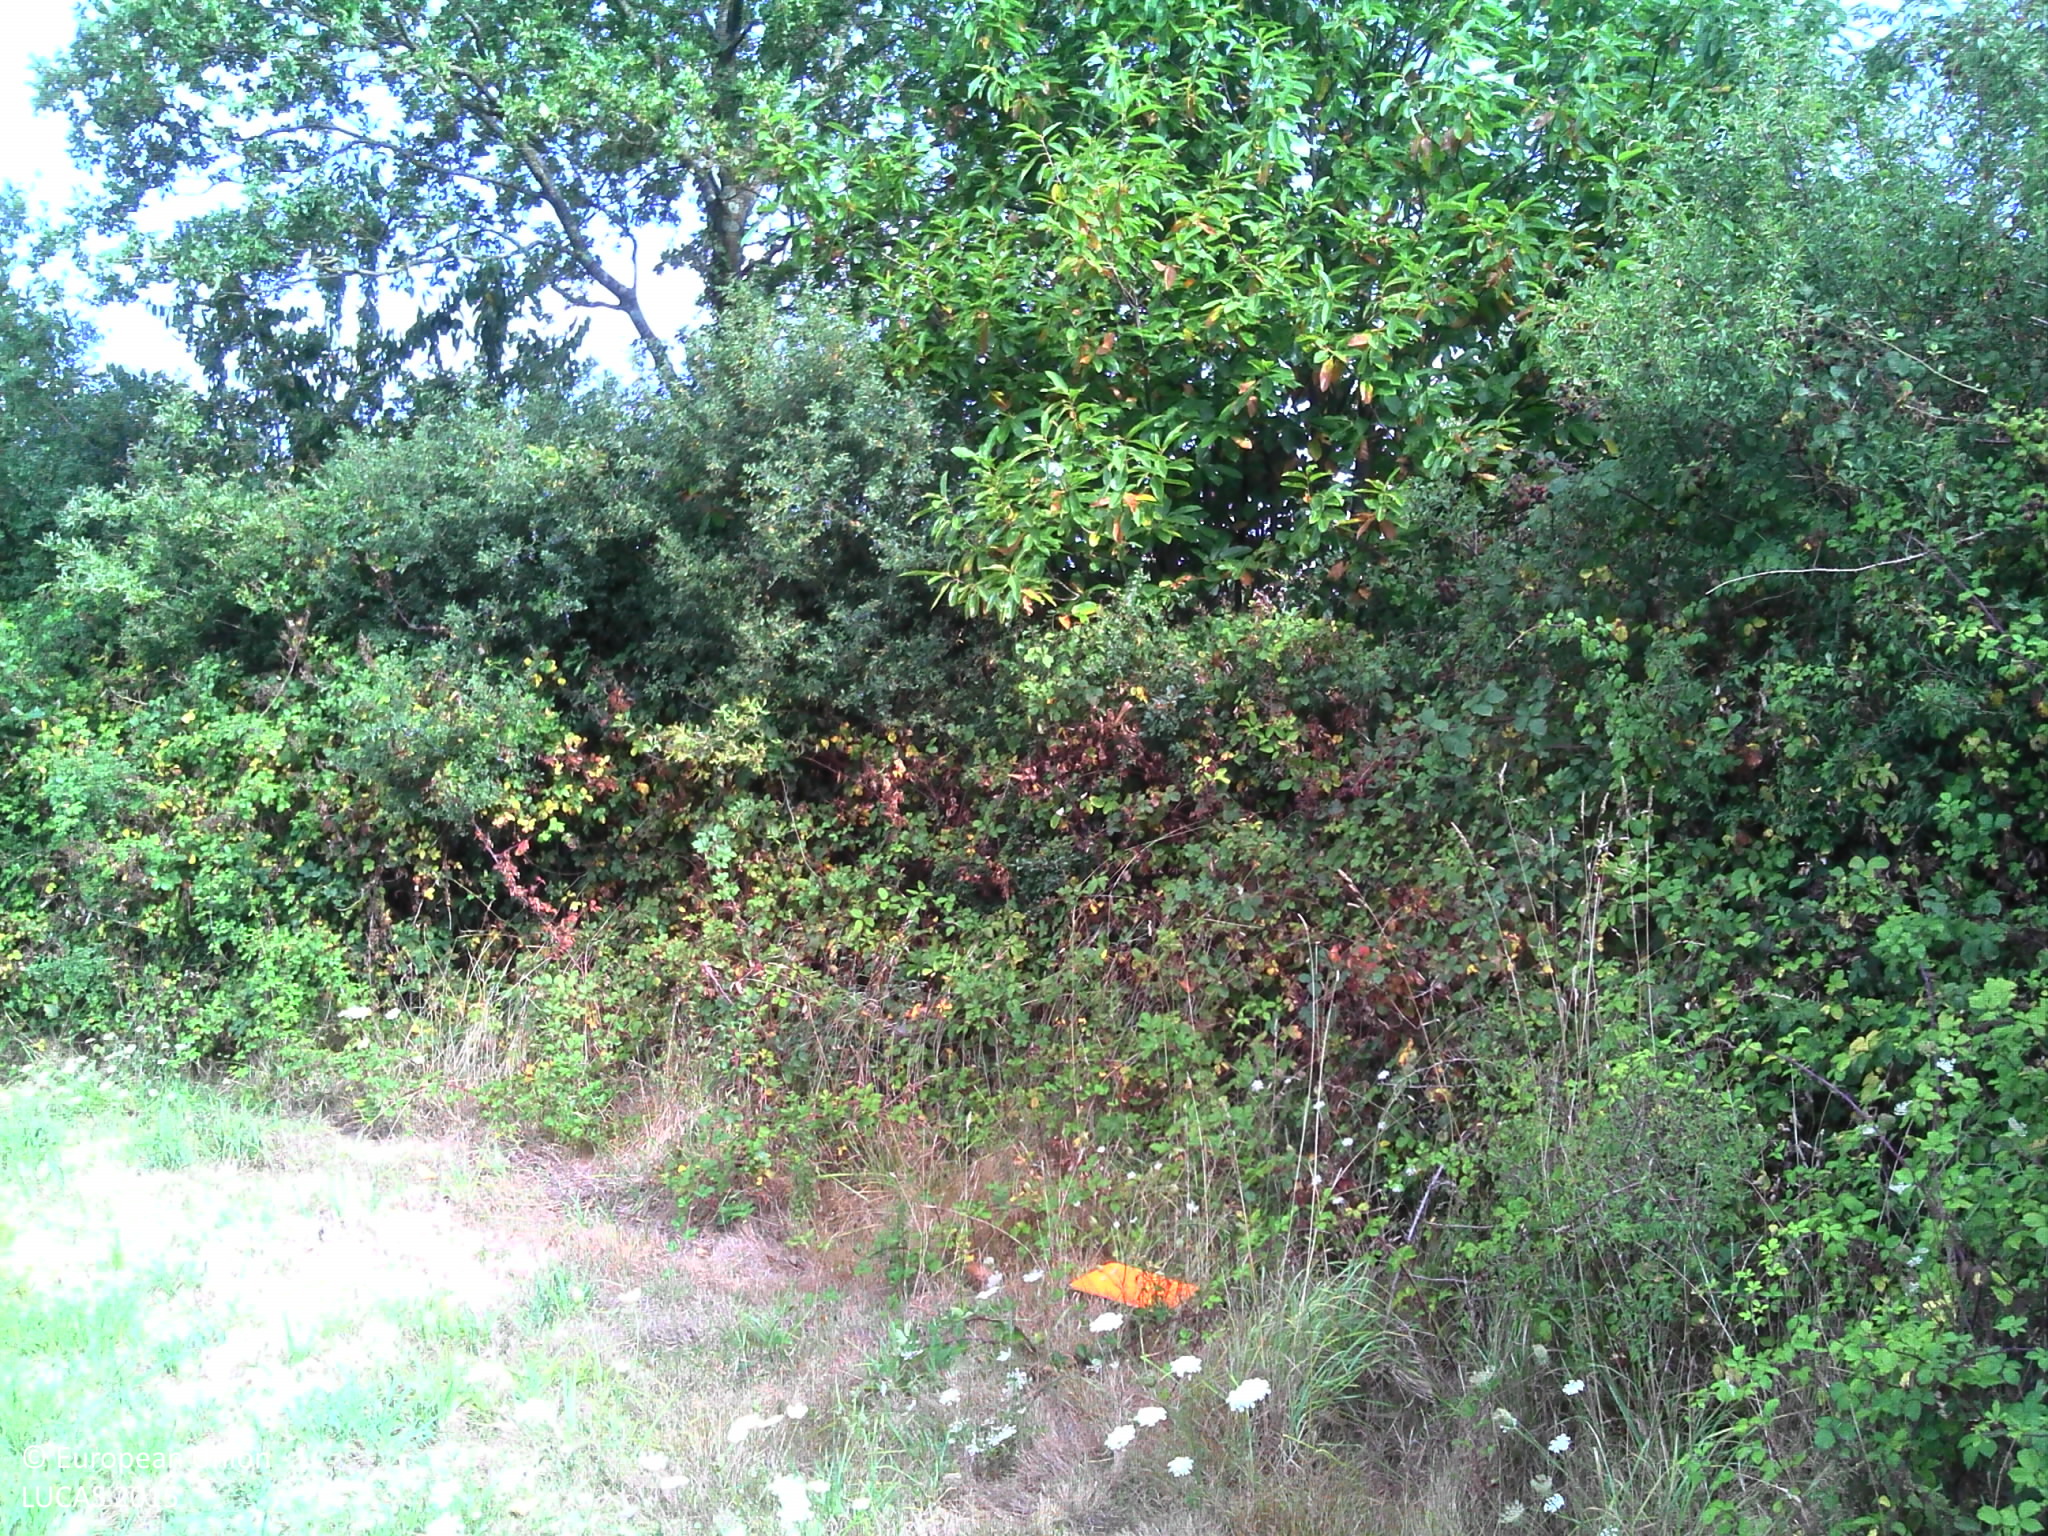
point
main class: Grassland
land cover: Grassland without tree/shrub cover
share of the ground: > 75 %
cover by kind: herbaceous plants 100 %
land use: Agriculture (excluding fallow land and kitchen gardens)
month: August
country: FR
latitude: 47.4054
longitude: -1.8004
